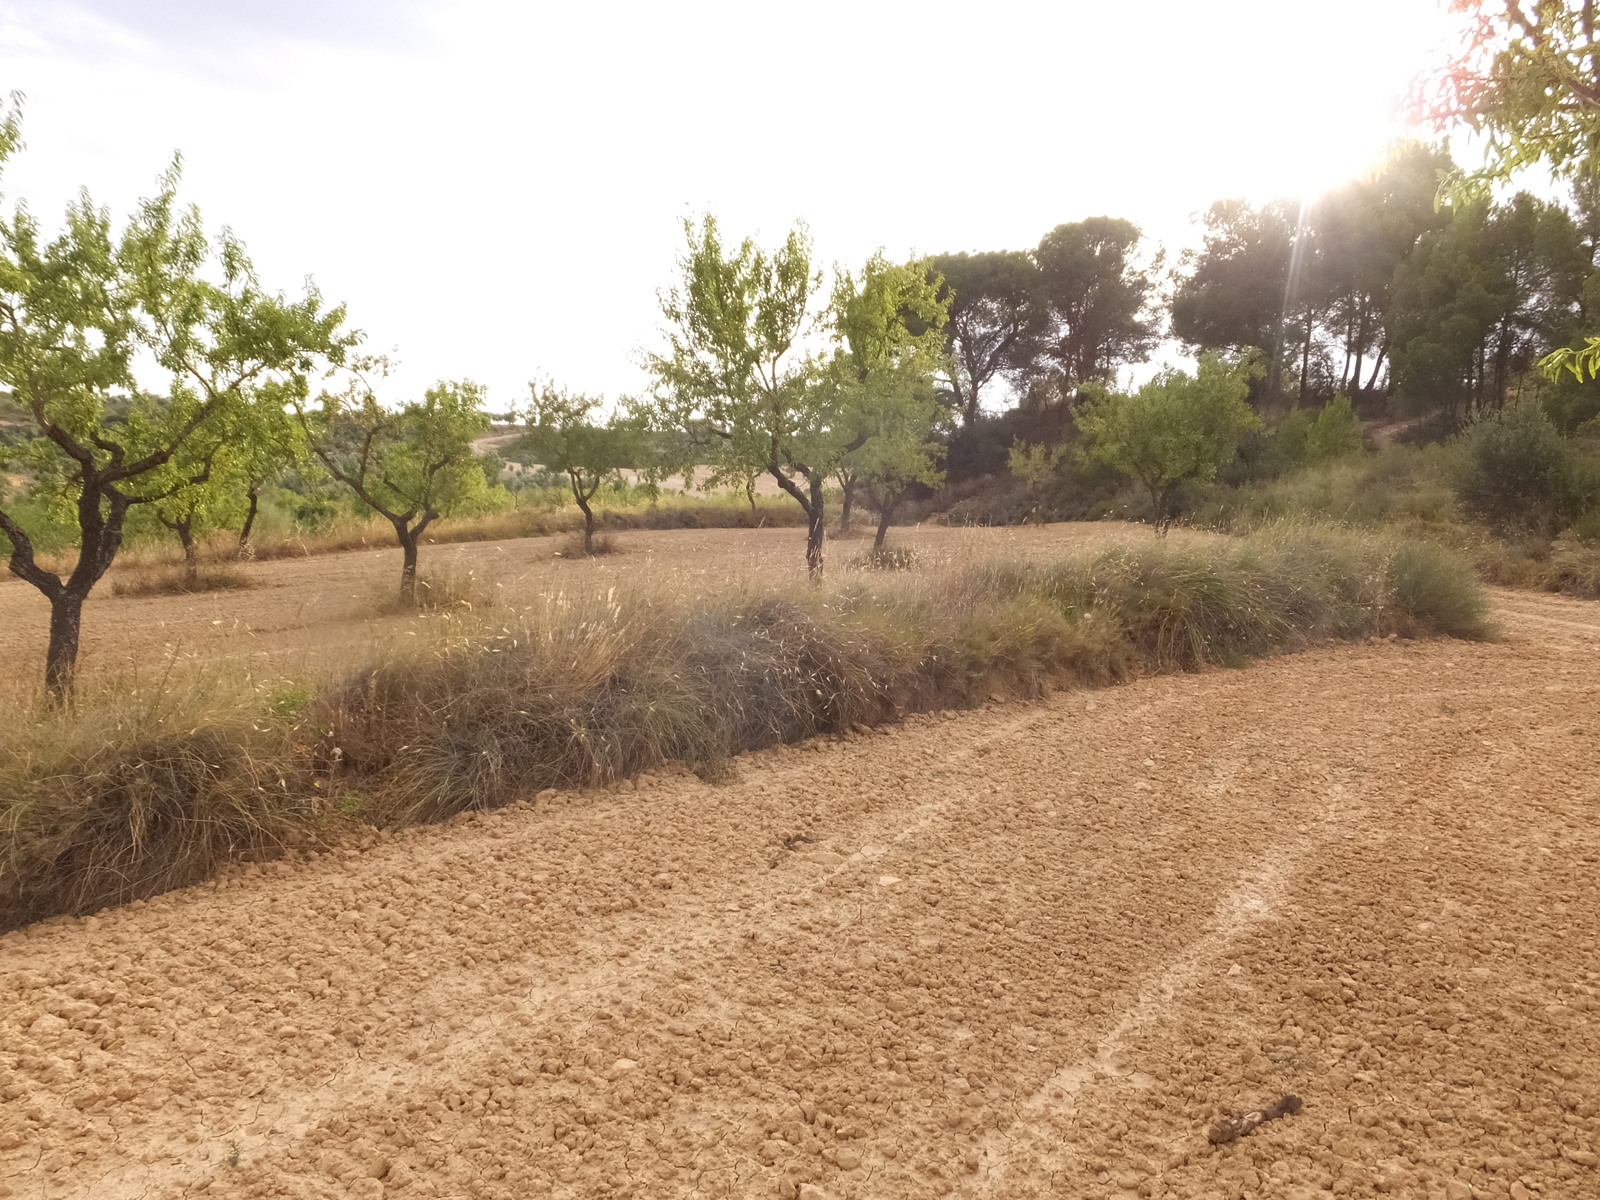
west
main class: Cropland
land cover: Nuts trees
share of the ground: 50 - 75 %
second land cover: Other bare soil
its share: > 75 %
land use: Agriculture (excluding fallow land and kitchen gardens)
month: July
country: ES
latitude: 41.3666
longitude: 0.4608
